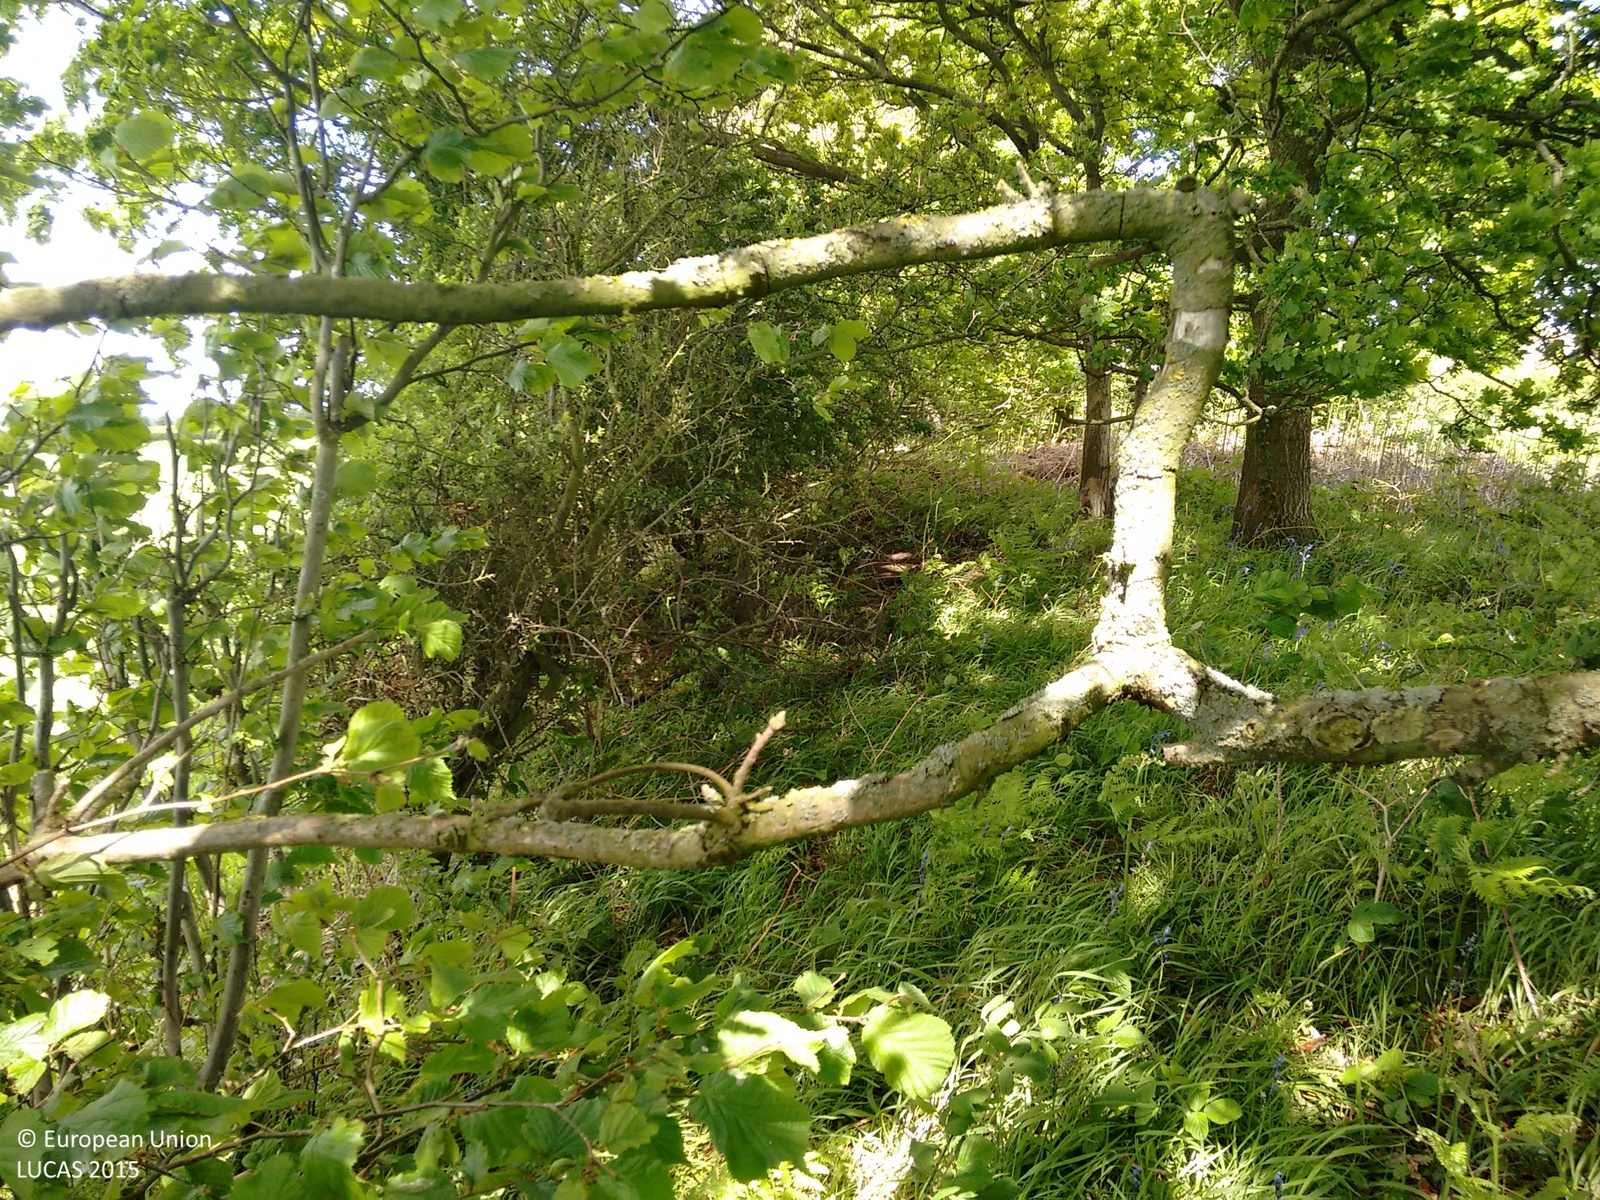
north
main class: Cropland
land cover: Temporary grasslands
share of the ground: > 75 %
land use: Agriculture (excluding fallow land and kitchen gardens)
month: May
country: GB
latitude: 53.9422
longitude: -1.3051
